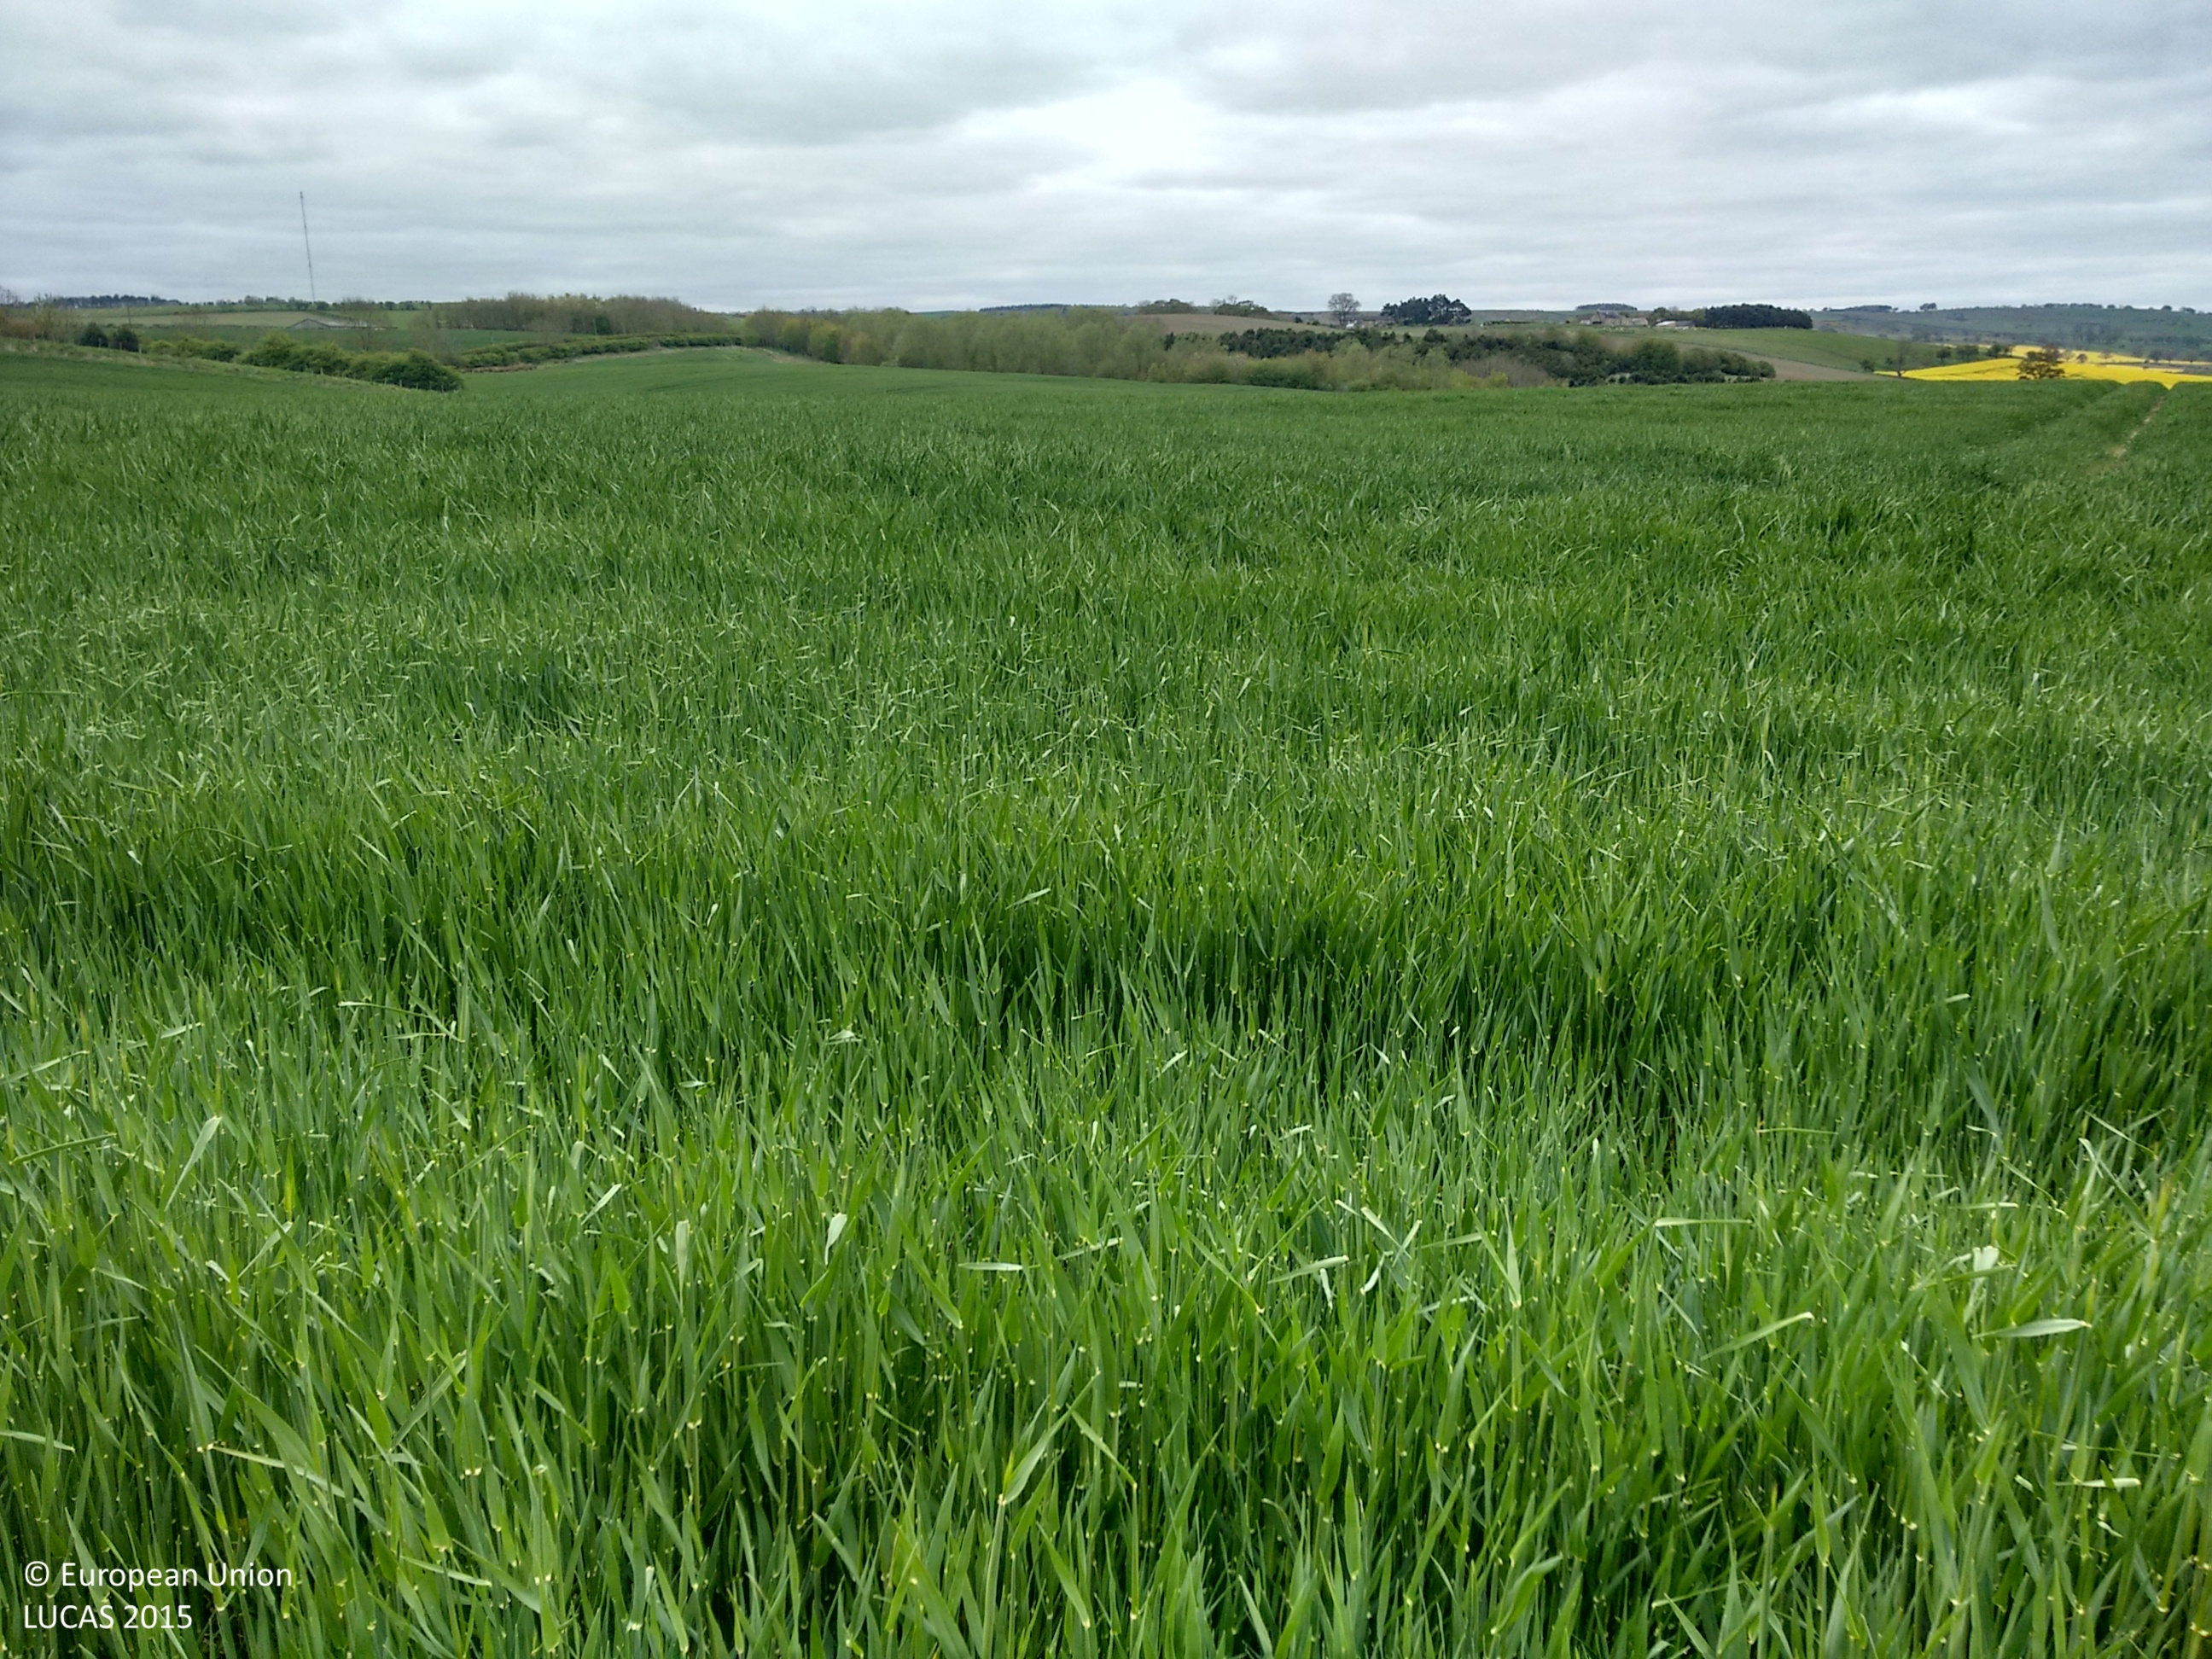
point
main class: Cropland
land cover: Barley
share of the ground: > 75 %
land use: Agriculture (excluding fallow land and kitchen gardens)
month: May
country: GB
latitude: 55.0551
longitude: -2.0306
